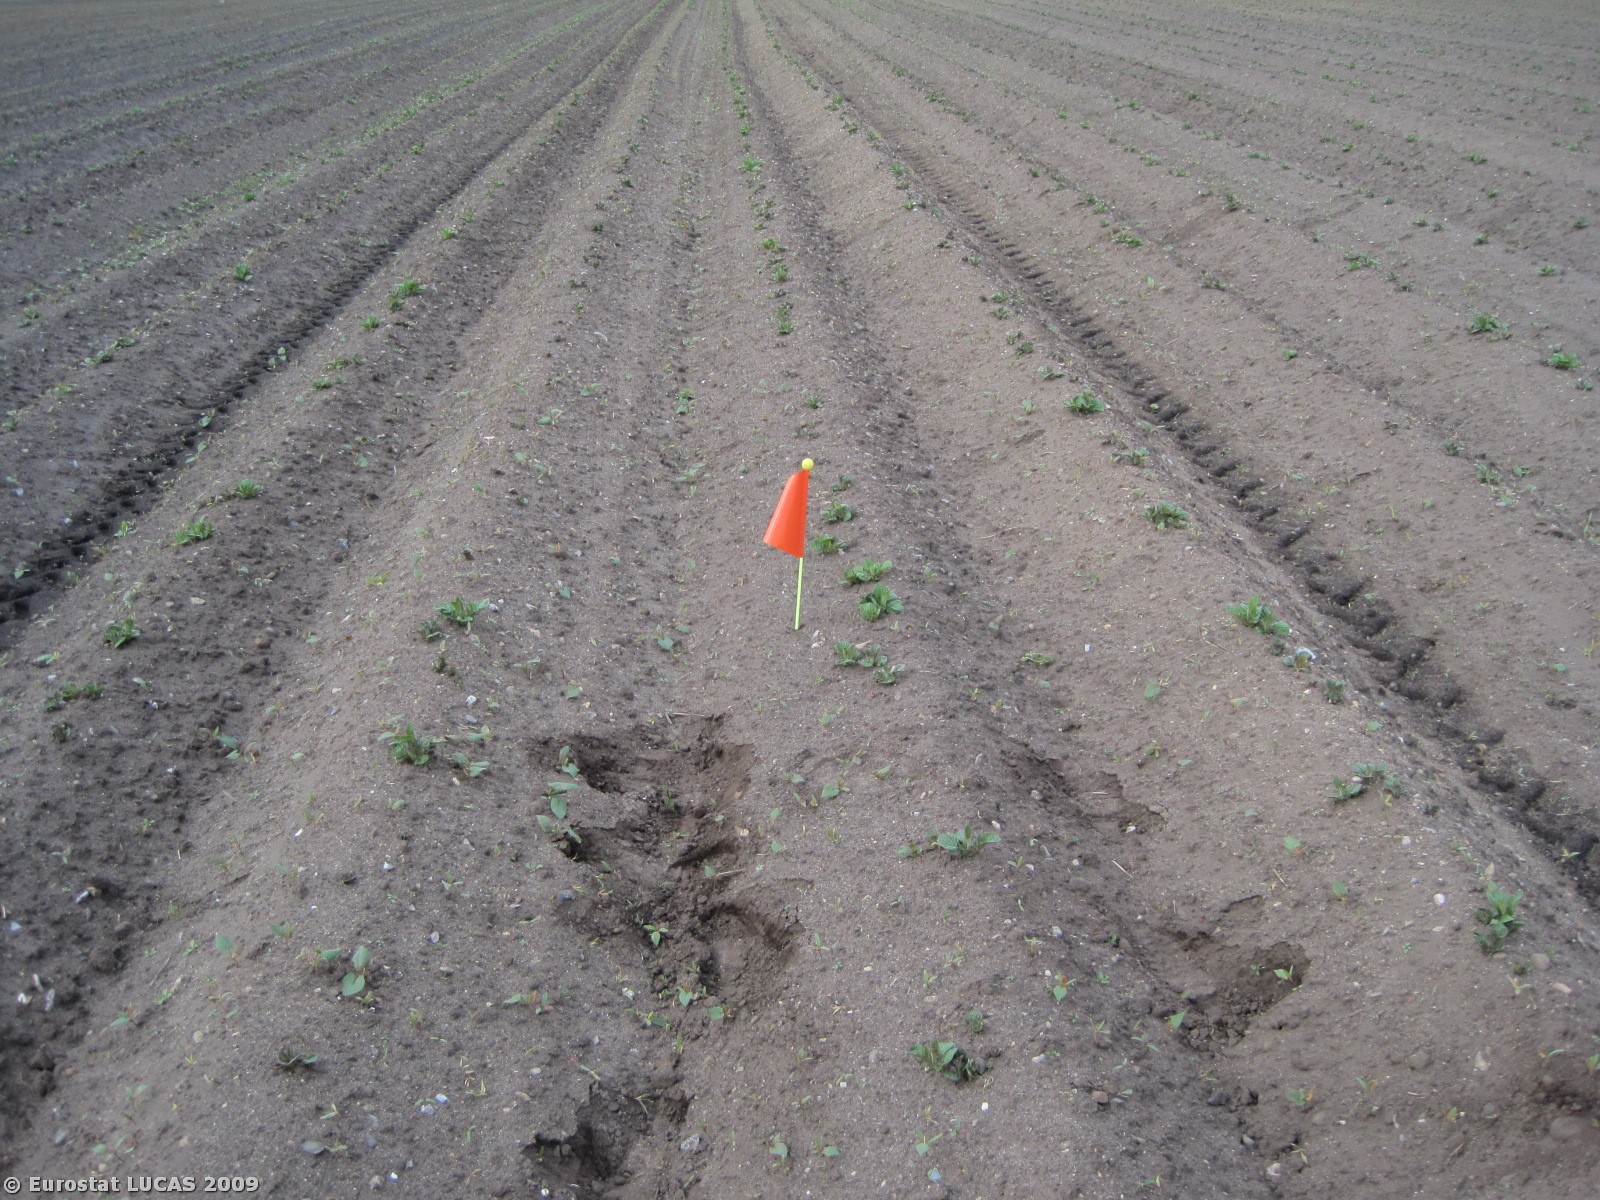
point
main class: Cropland
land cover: Potatoes
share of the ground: < 10 %
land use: Agriculture (excluding fallow land and kitchen gardens)
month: May
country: DK
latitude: 56.3830
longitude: 9.2074
